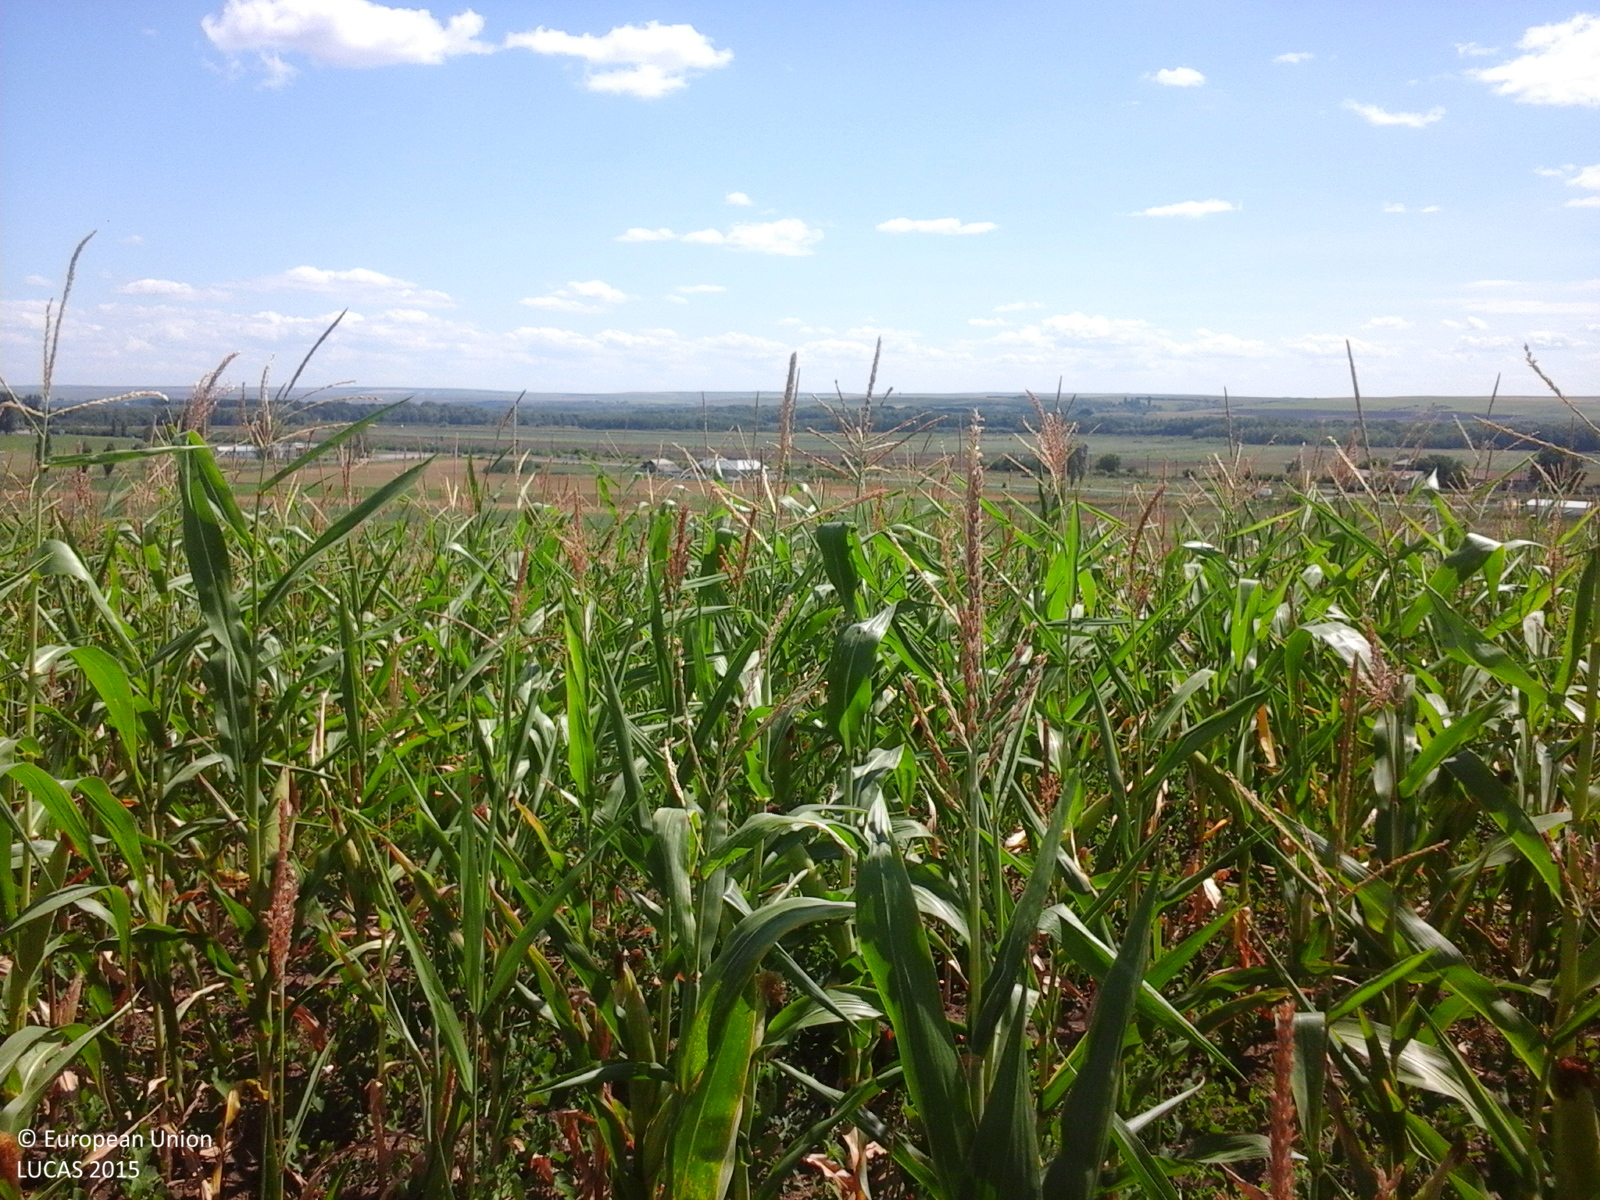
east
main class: Cropland
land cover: Maize
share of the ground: > 75 %
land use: Agriculture (excluding fallow land and kitchen gardens)
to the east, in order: Maize; Common wheat; Spontaneously vegetated surfaces; Tracks; Spontaneously vegetated surfaces; Lucerne; Tracks; Oats; Maize; Common wheat; Lucerne; Maize
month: July
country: RO
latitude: 46.0771
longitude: 27.4720
